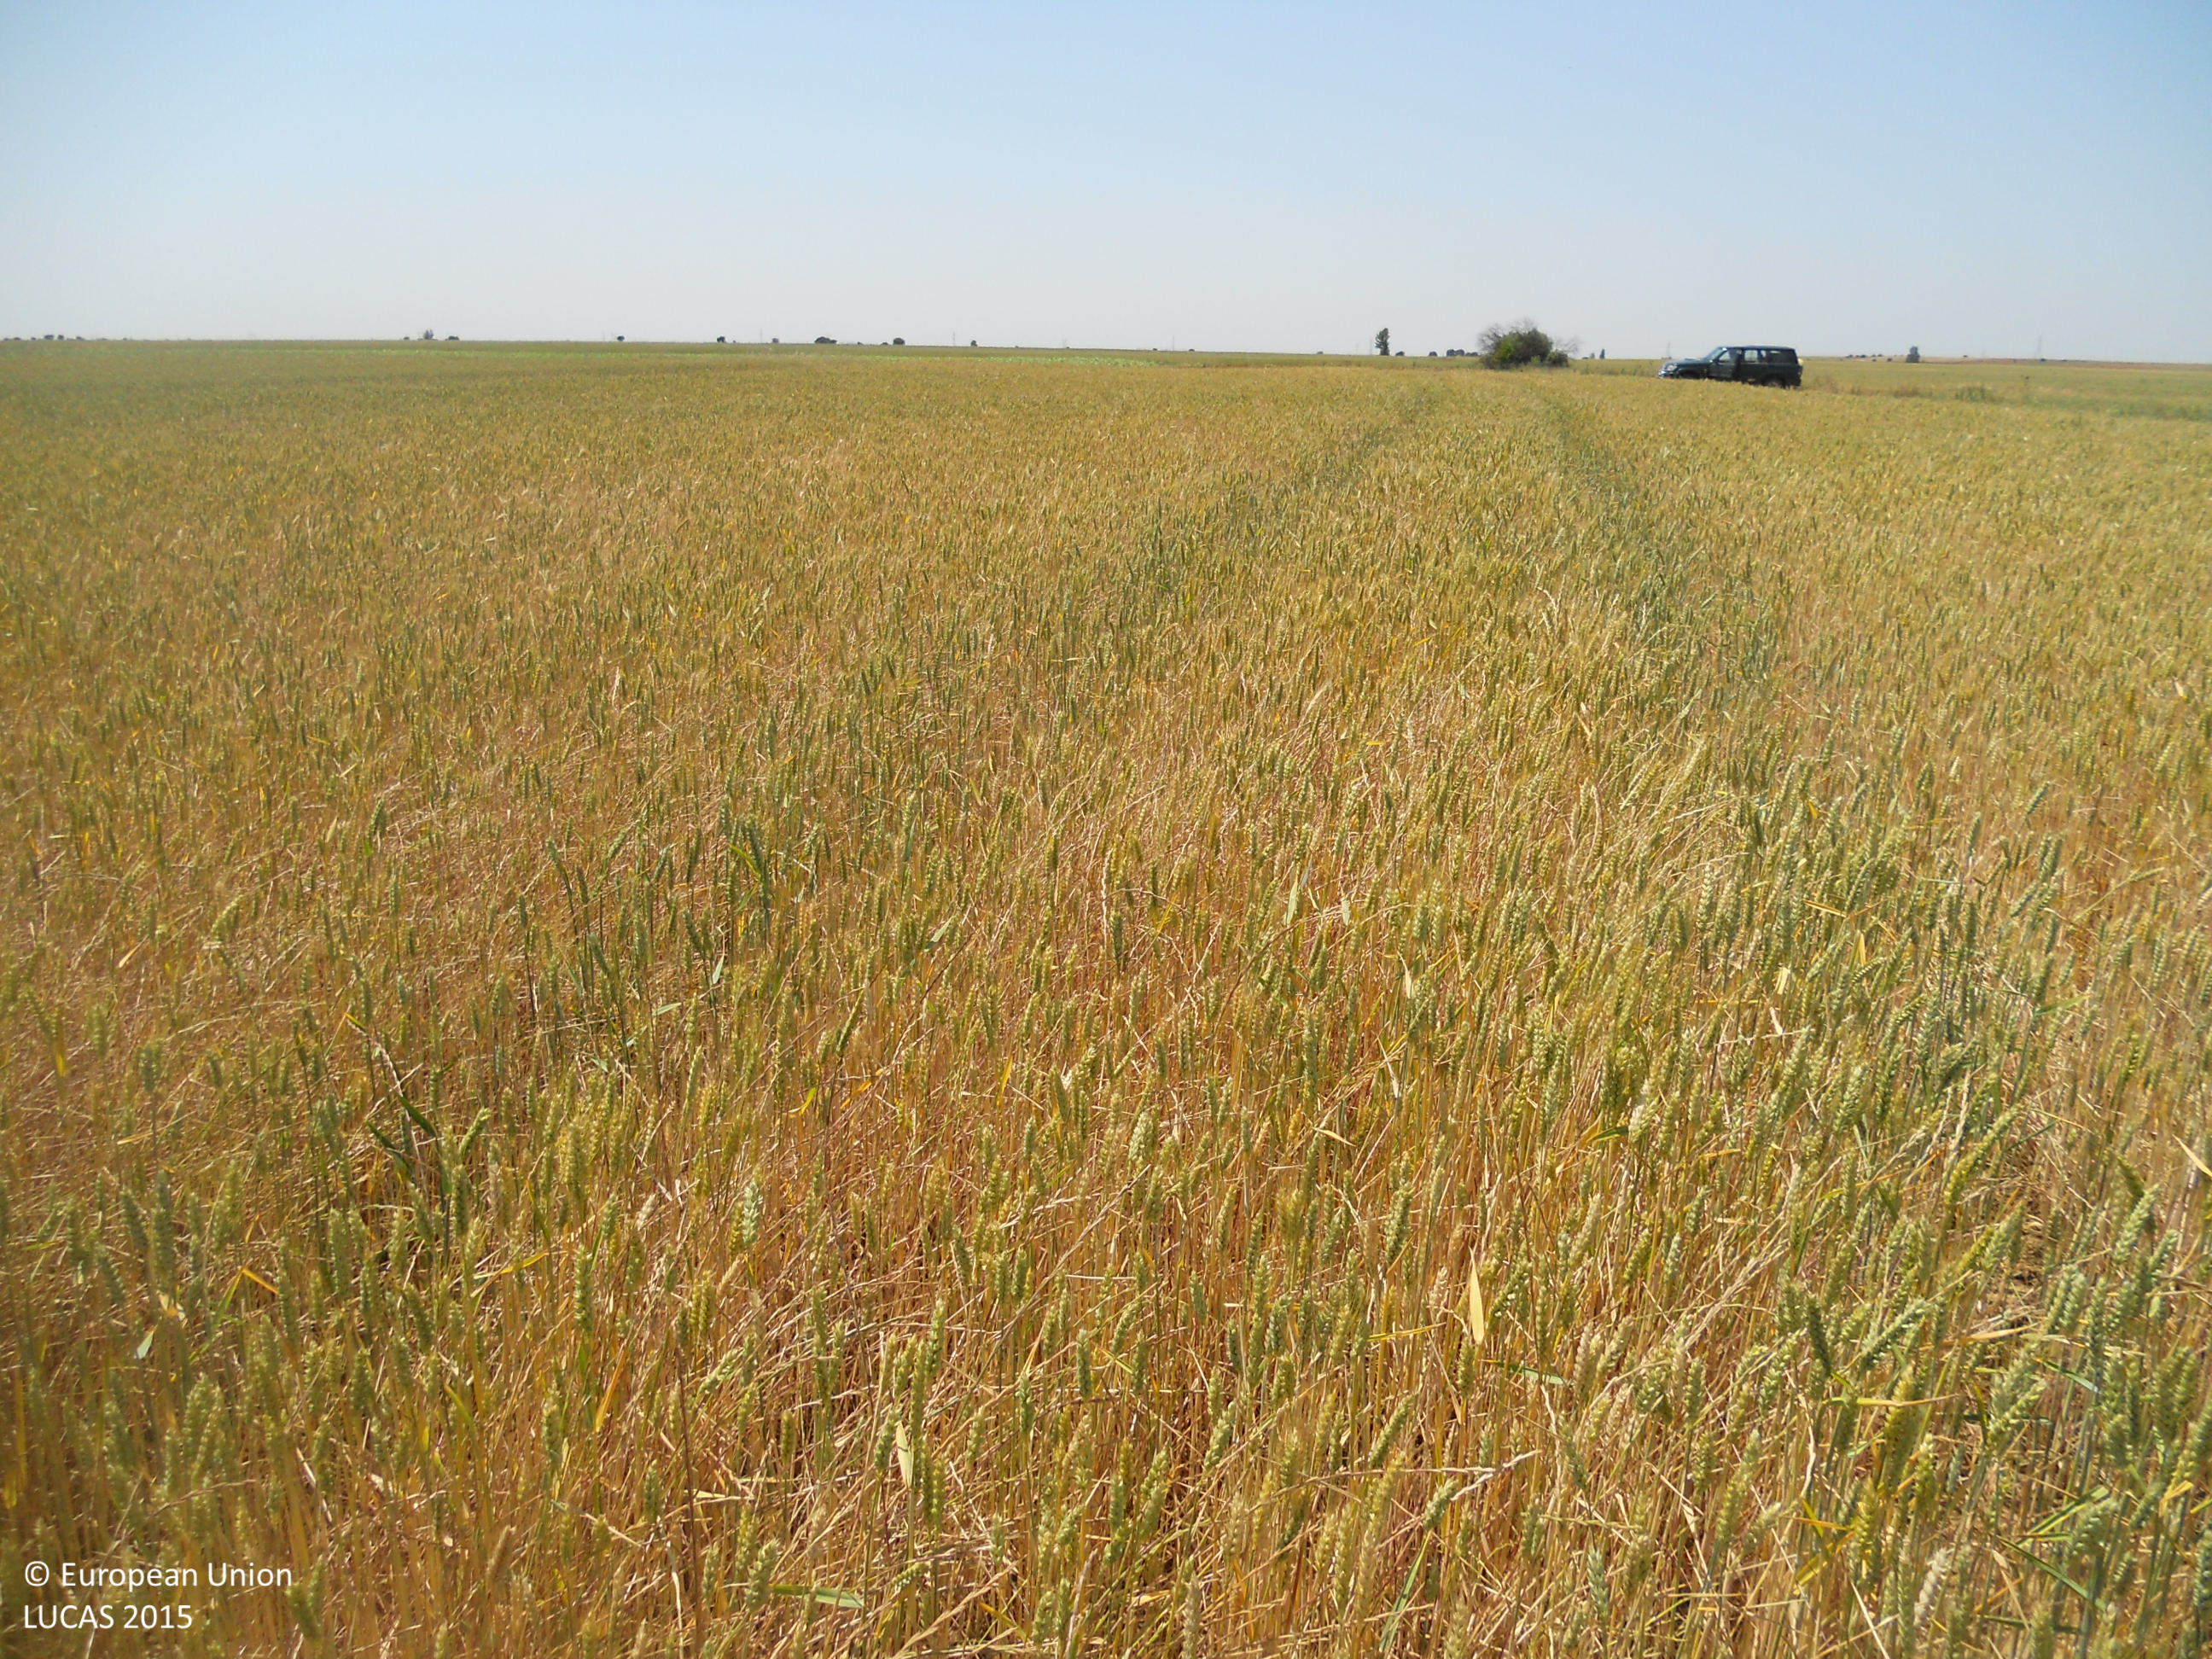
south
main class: Cropland
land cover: Common wheat
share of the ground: > 75 %
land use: Agriculture (excluding fallow land and kitchen gardens)
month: June
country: ES
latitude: 42.2294
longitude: -5.3425
